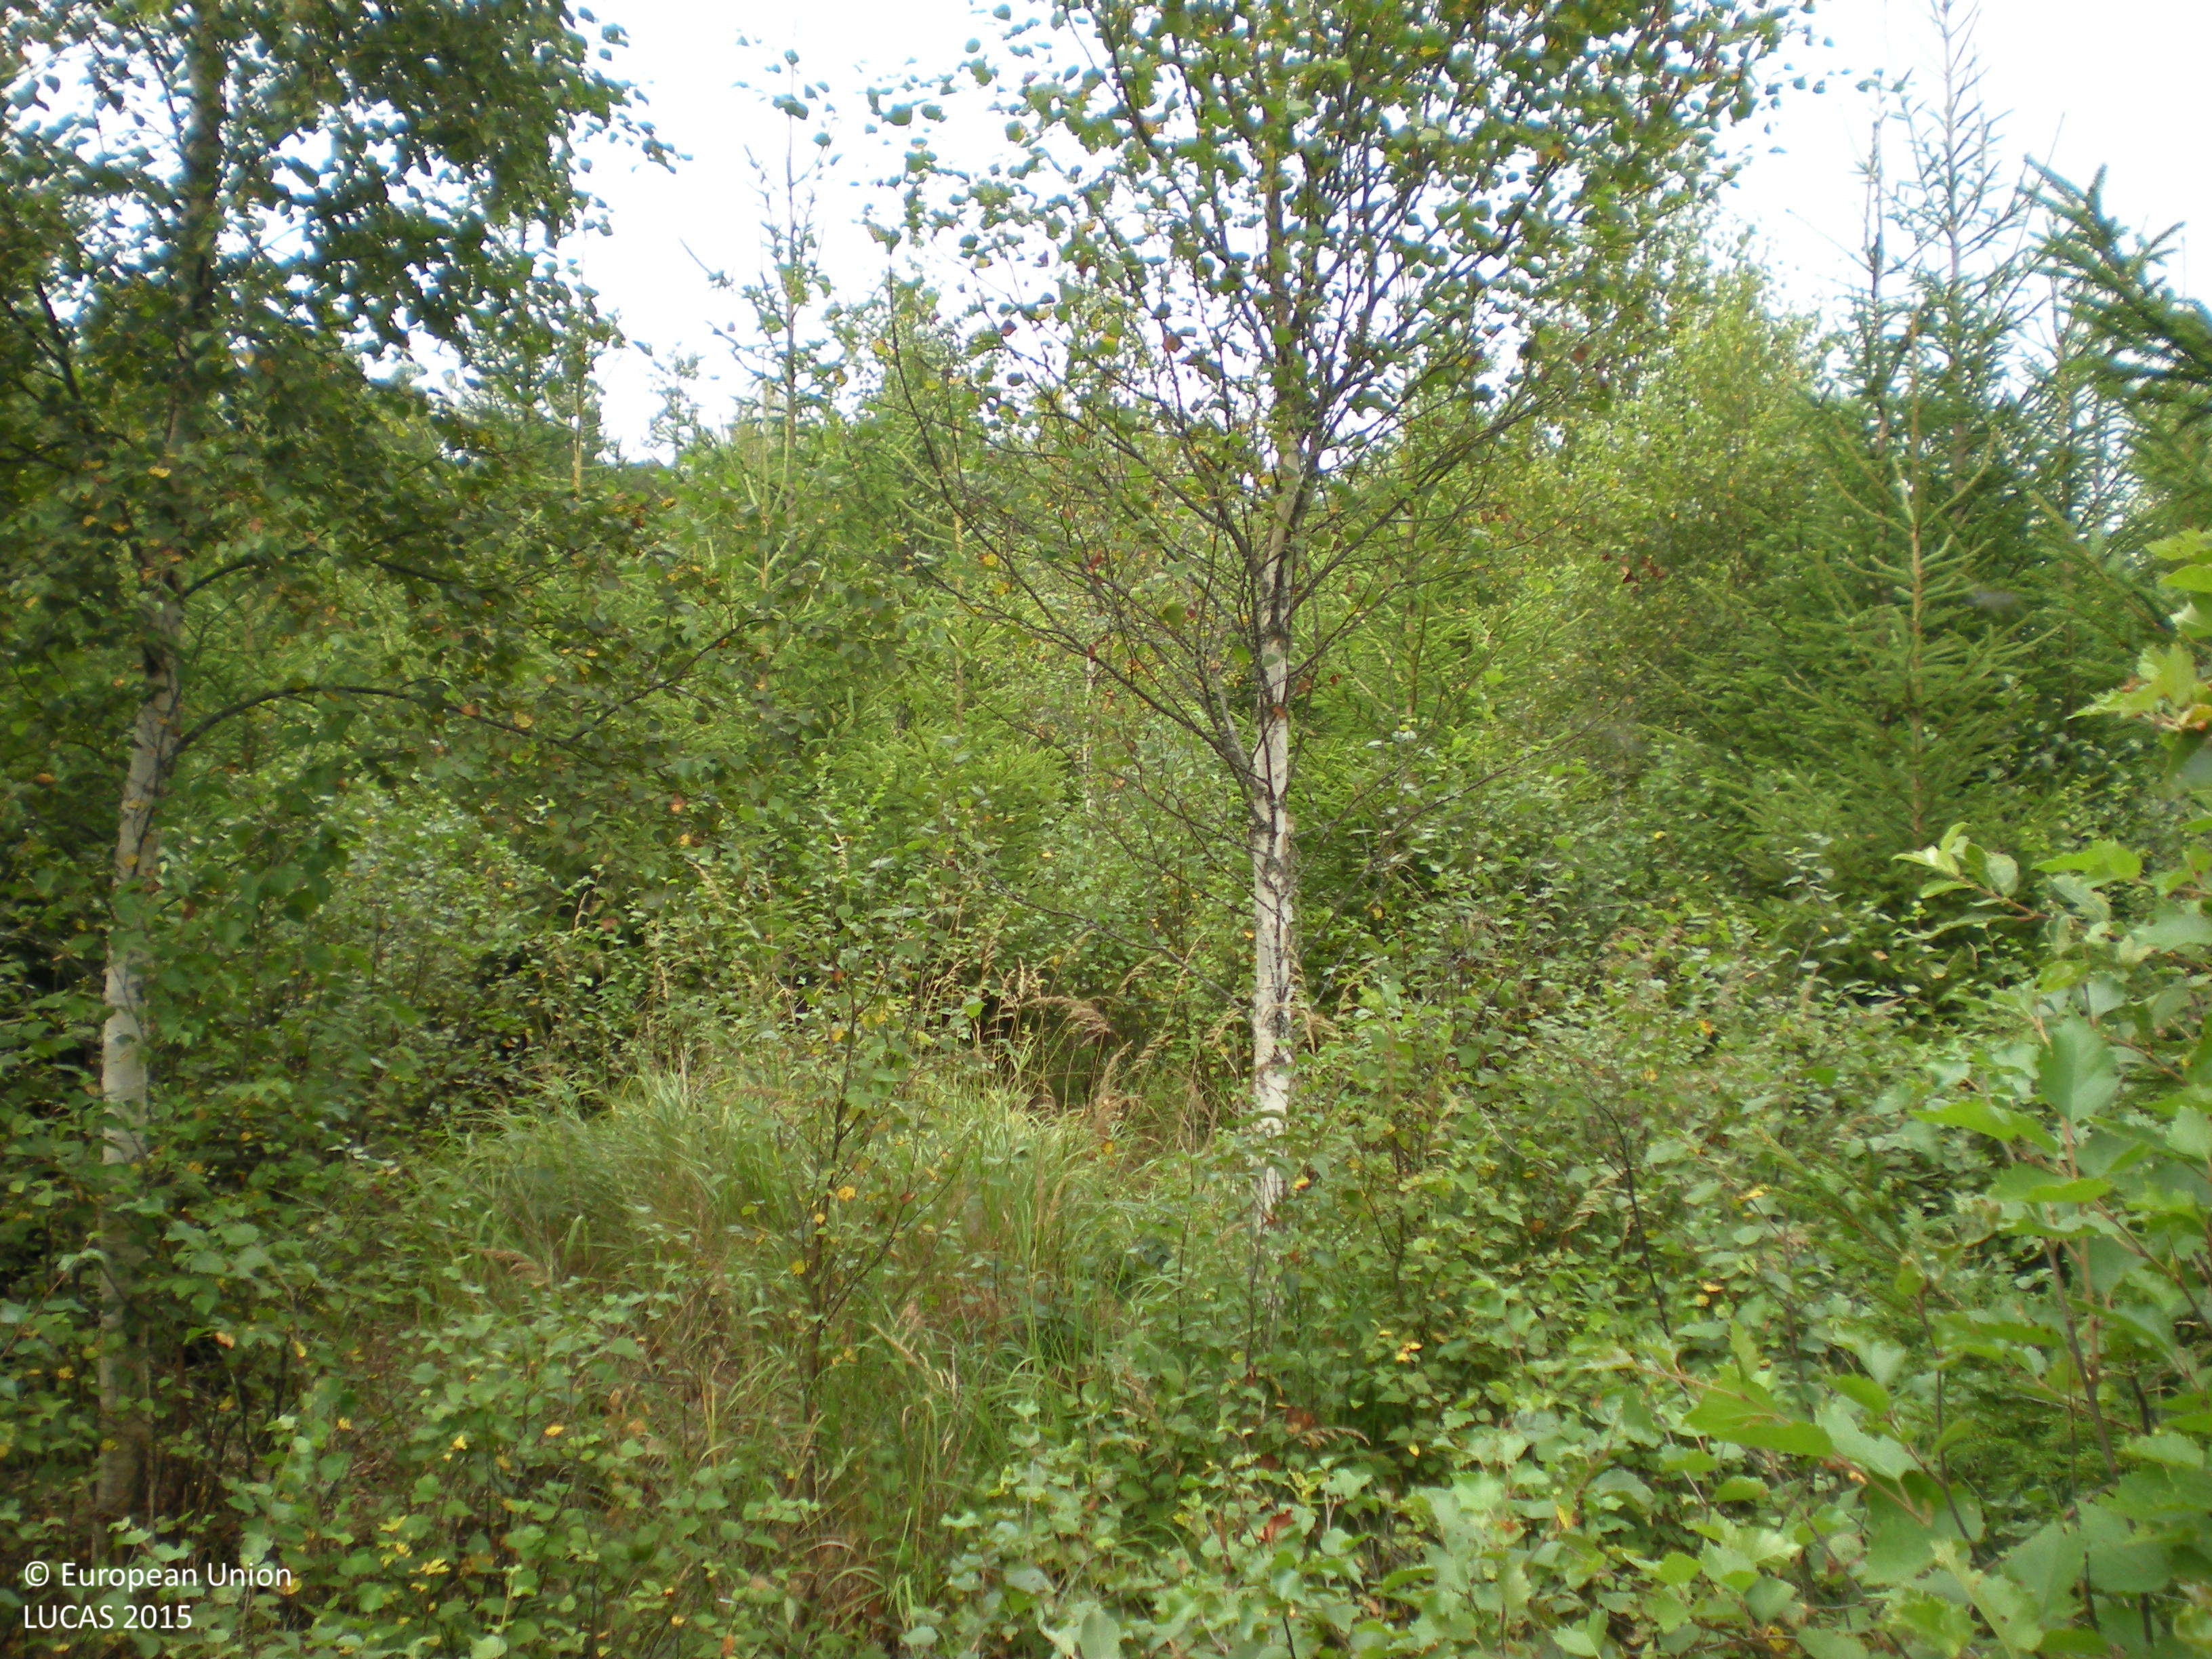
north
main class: Woodland
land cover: Spruce dominated mixed woodland
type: boreal forest
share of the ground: > 75 %
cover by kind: broadleaved forest trees 50 %, coniferous forest trees 40 %, herbaceous plants 10 %
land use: Forestry
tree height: < 5 m
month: August
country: SE
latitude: 60.5095
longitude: 17.0737
